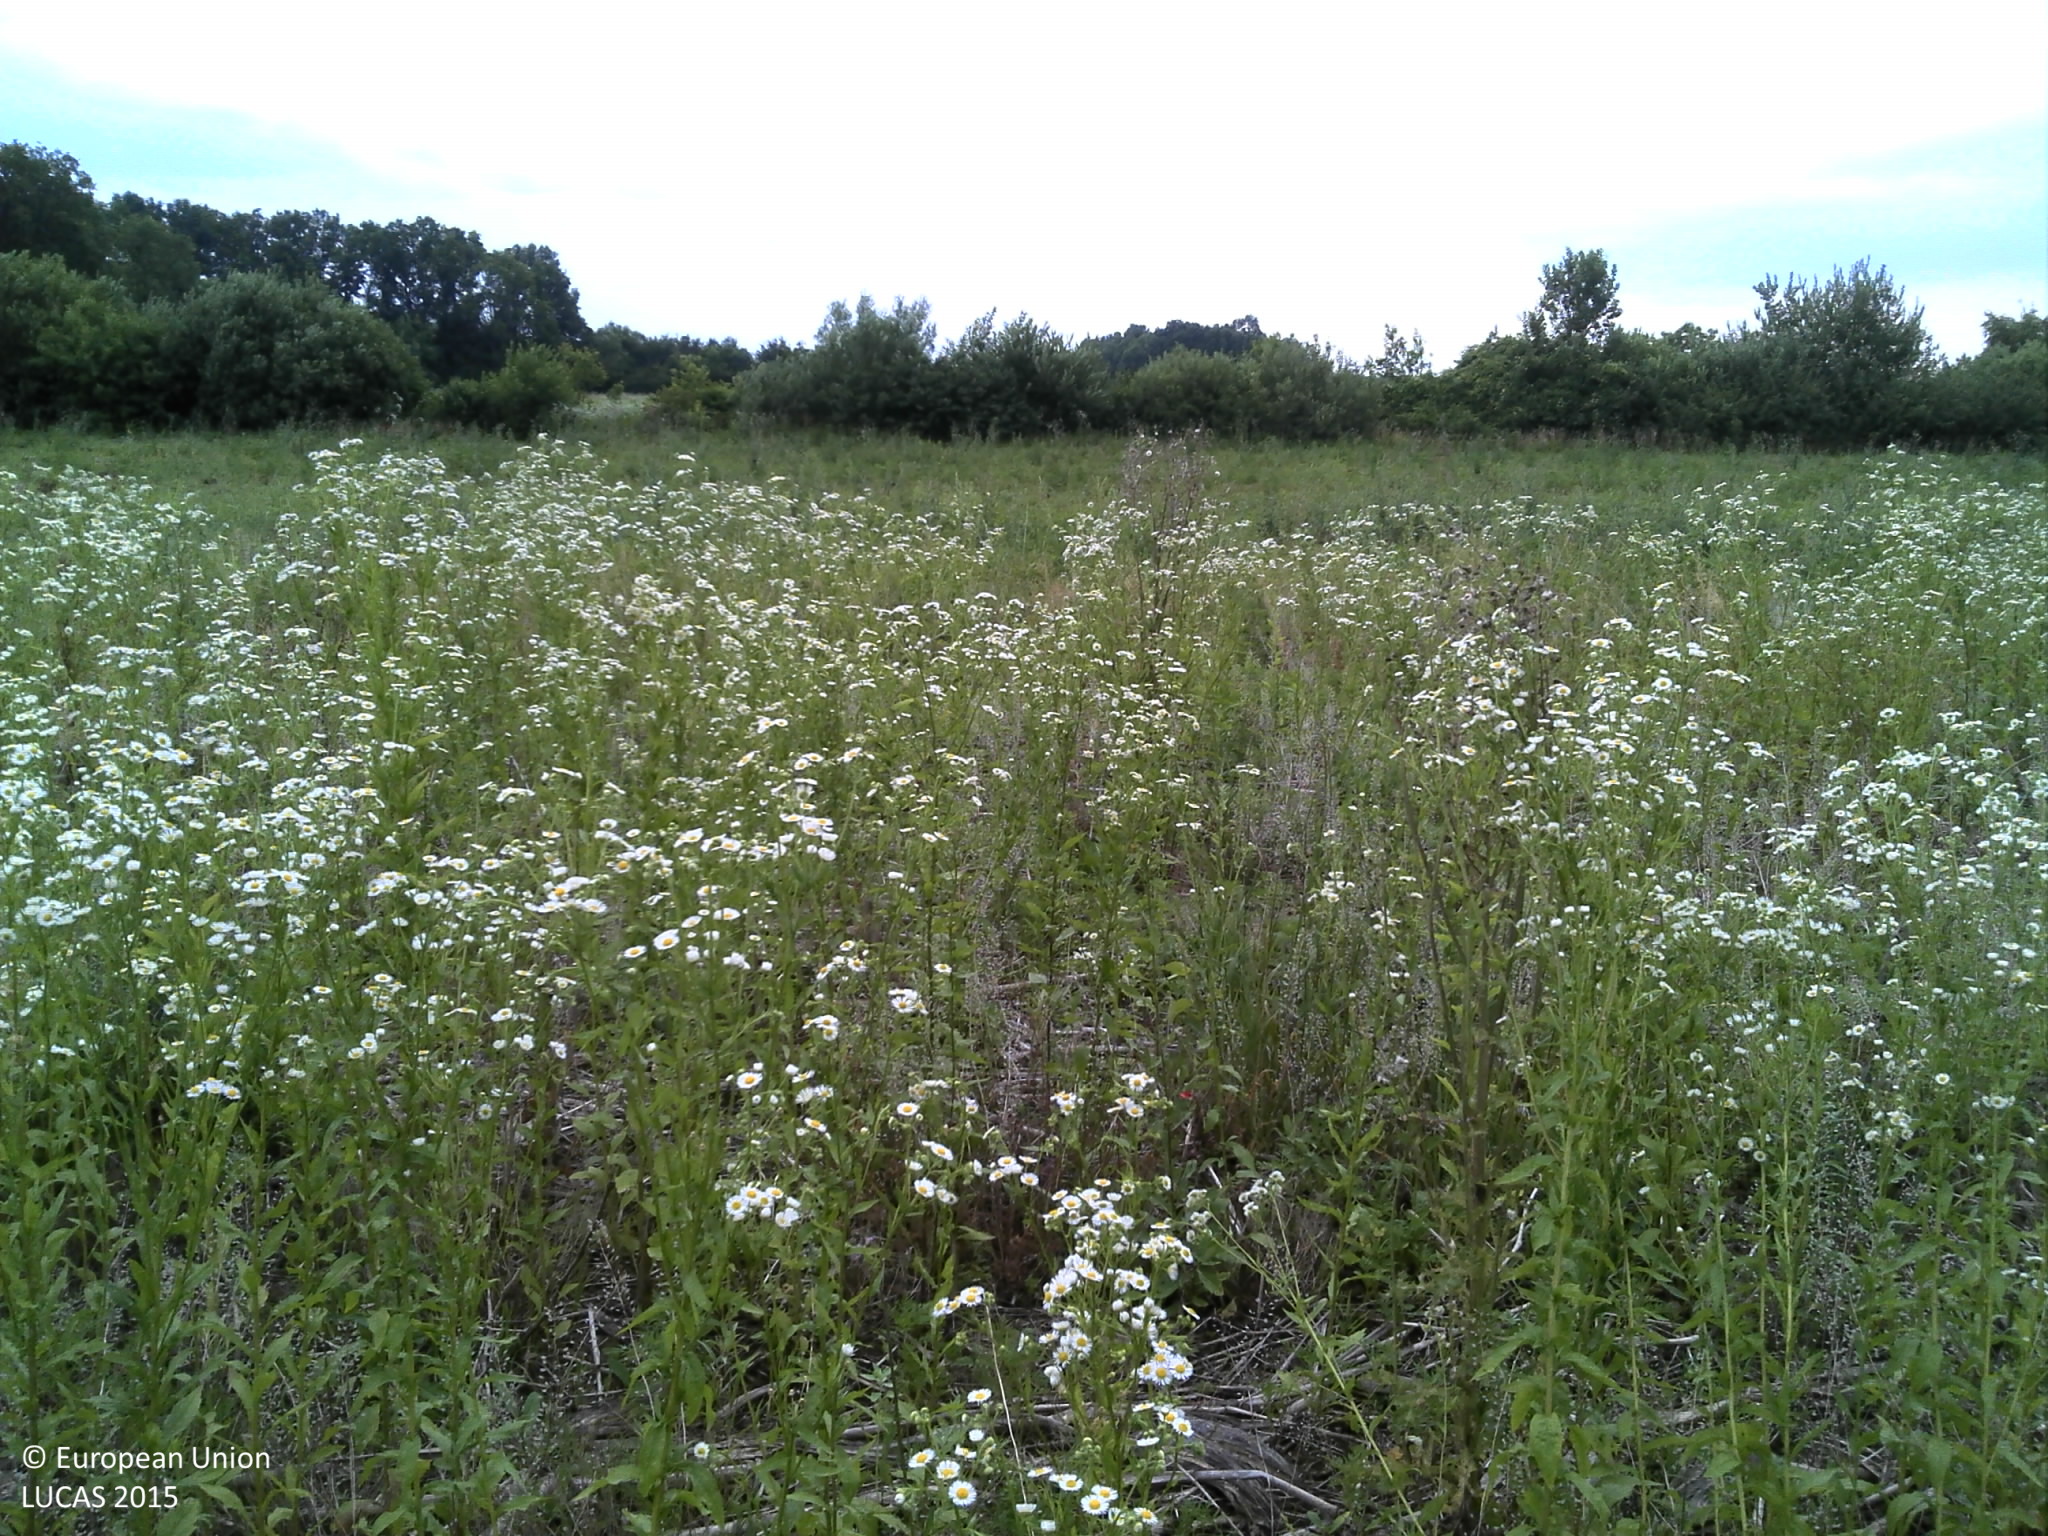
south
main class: Grassland
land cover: Spontaneously vegetated surfaces
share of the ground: 25 - 50 %
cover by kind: herbaceous plants 50 %, unconsolidated bare surface 50 %
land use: Fallow land
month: June
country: HR
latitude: 45.2031
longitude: 17.4733
